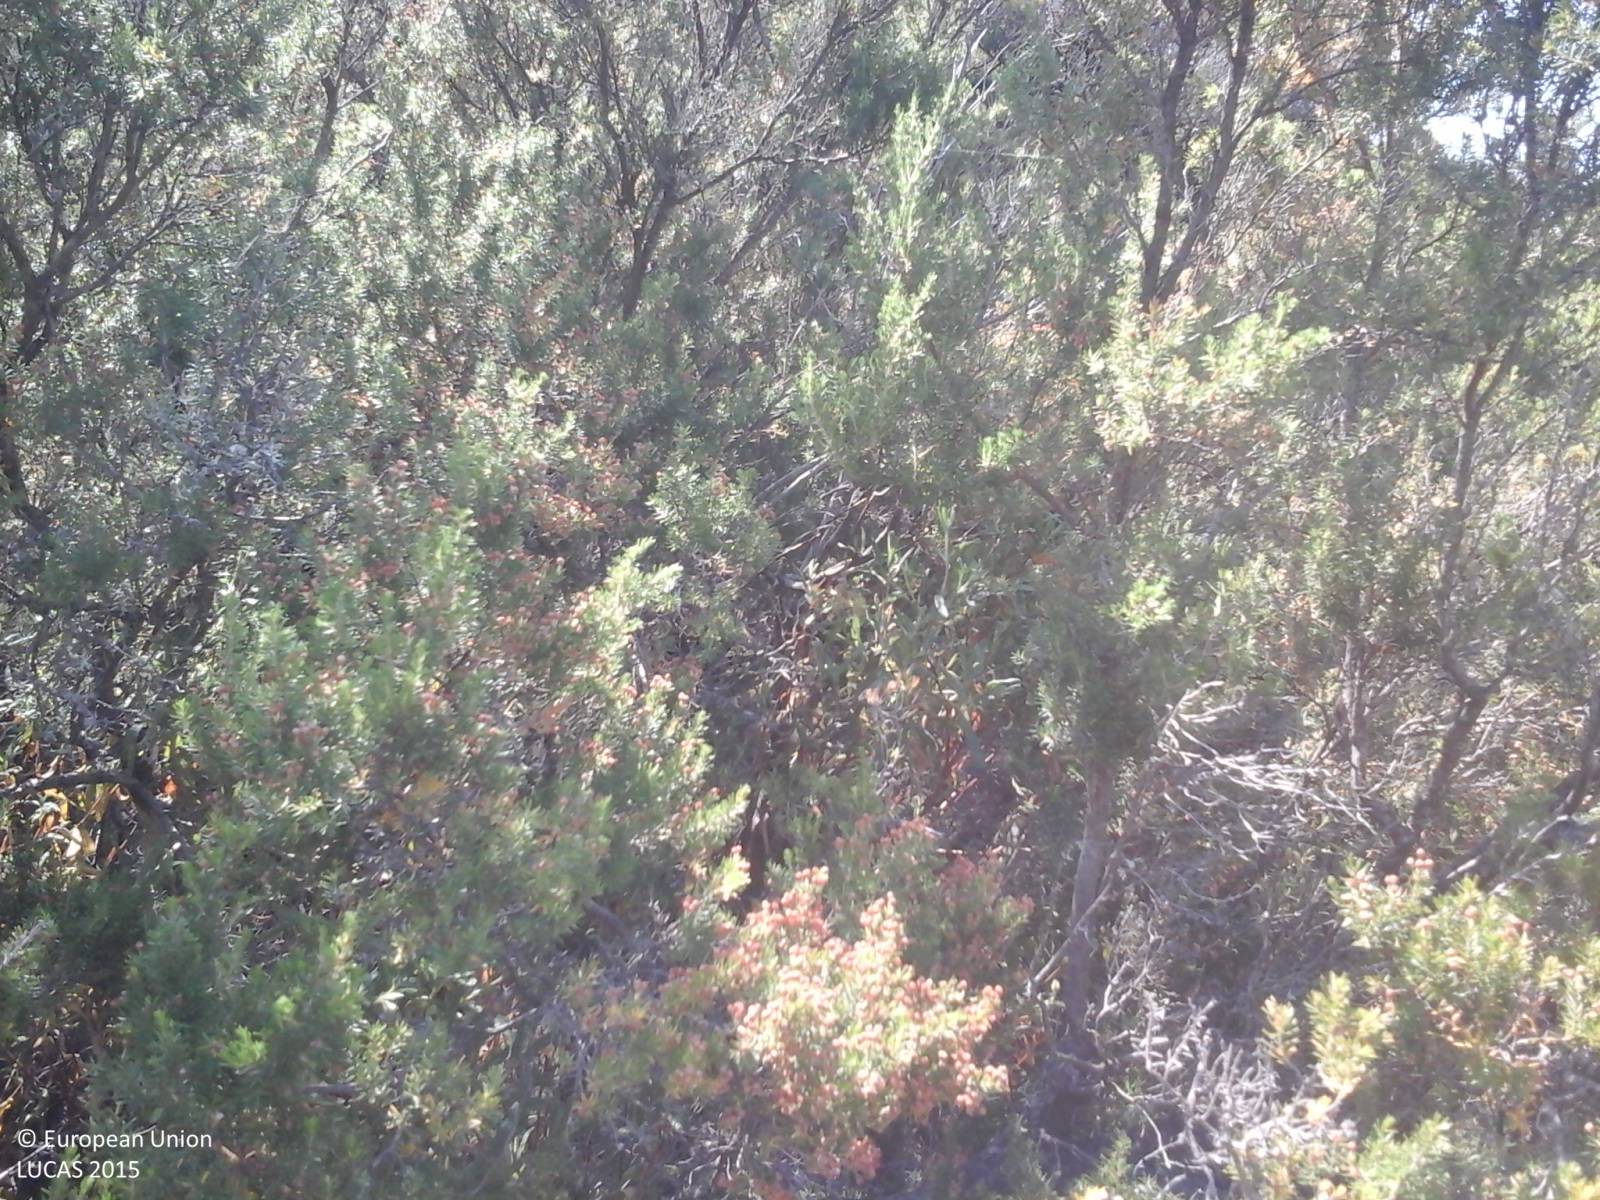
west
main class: Shrubland
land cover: Shrubland without tree cover
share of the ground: > 75 %
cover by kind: shrubs 95 %, herbaceous plants 5 %
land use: Semi-natural and natural areas not in use
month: June
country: IT
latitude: 40.5744
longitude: 9.6356
